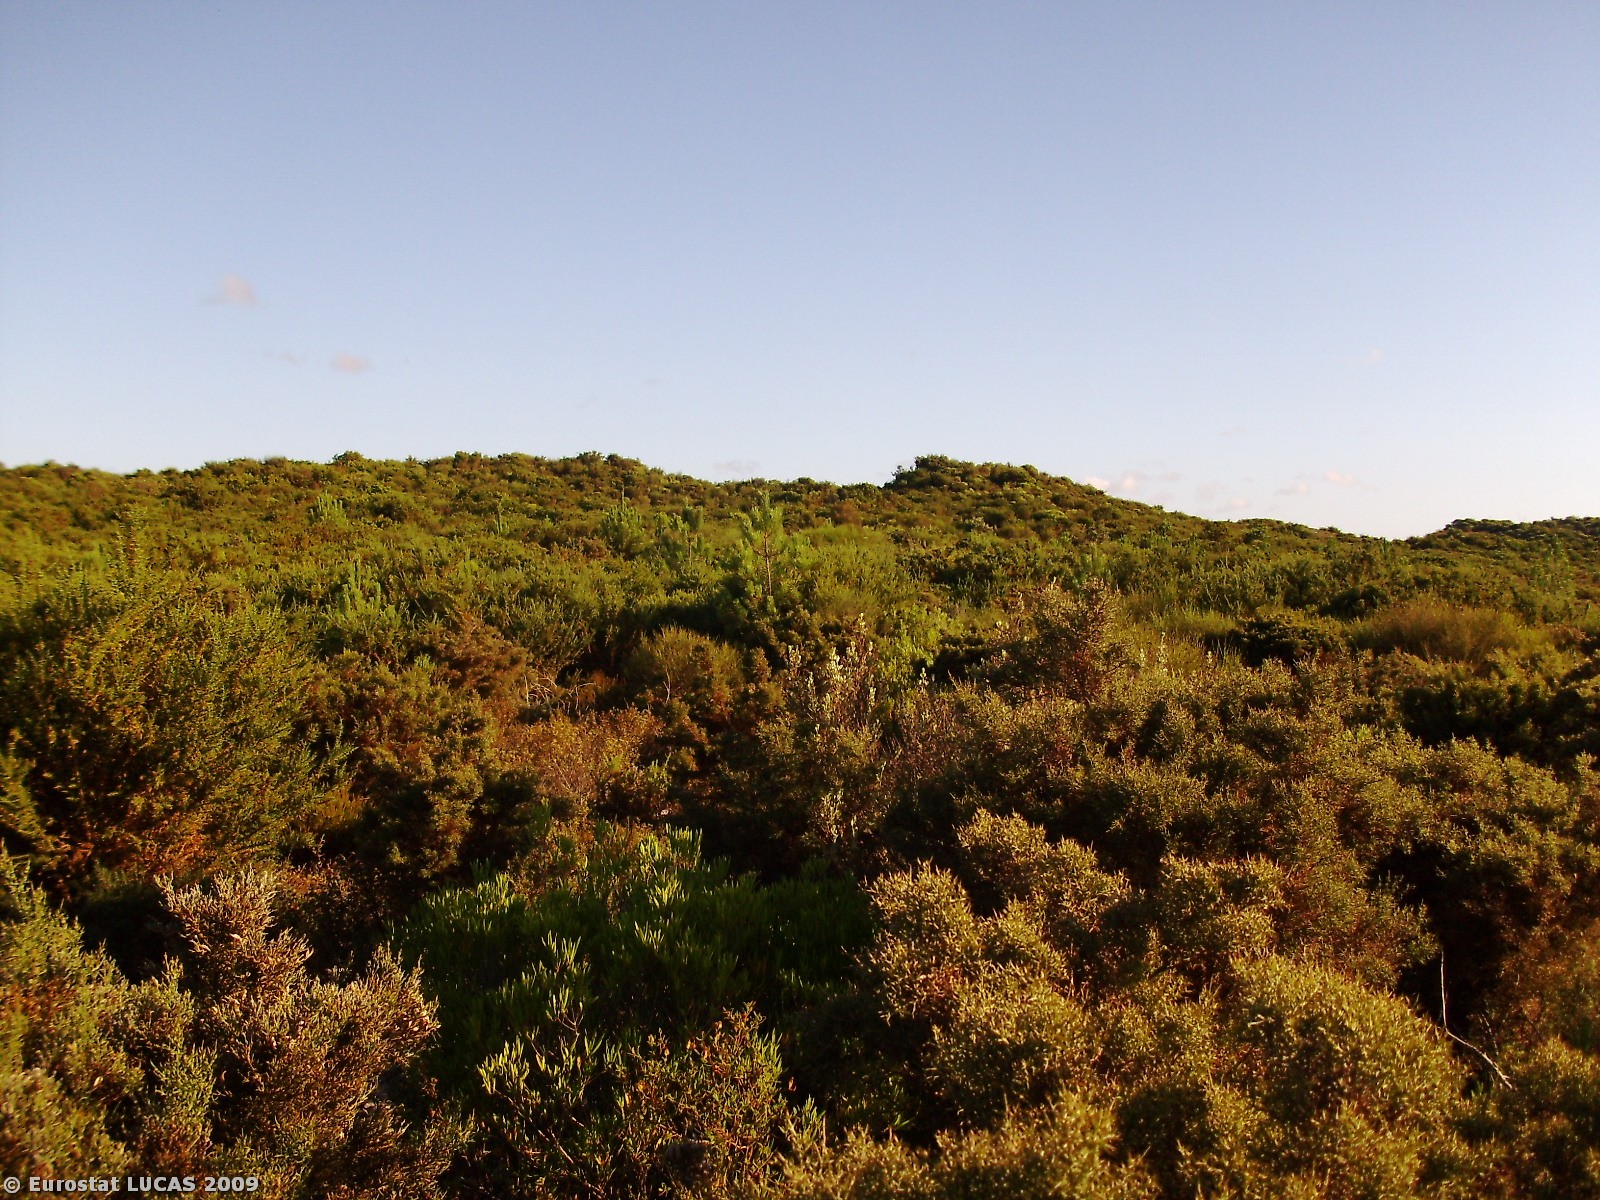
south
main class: Shrubland
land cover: Shrubland without tree cover
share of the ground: > 75 %
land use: Nature reserves
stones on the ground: < 10 %
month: July
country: PT
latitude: 39.8253
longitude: -8.9608
